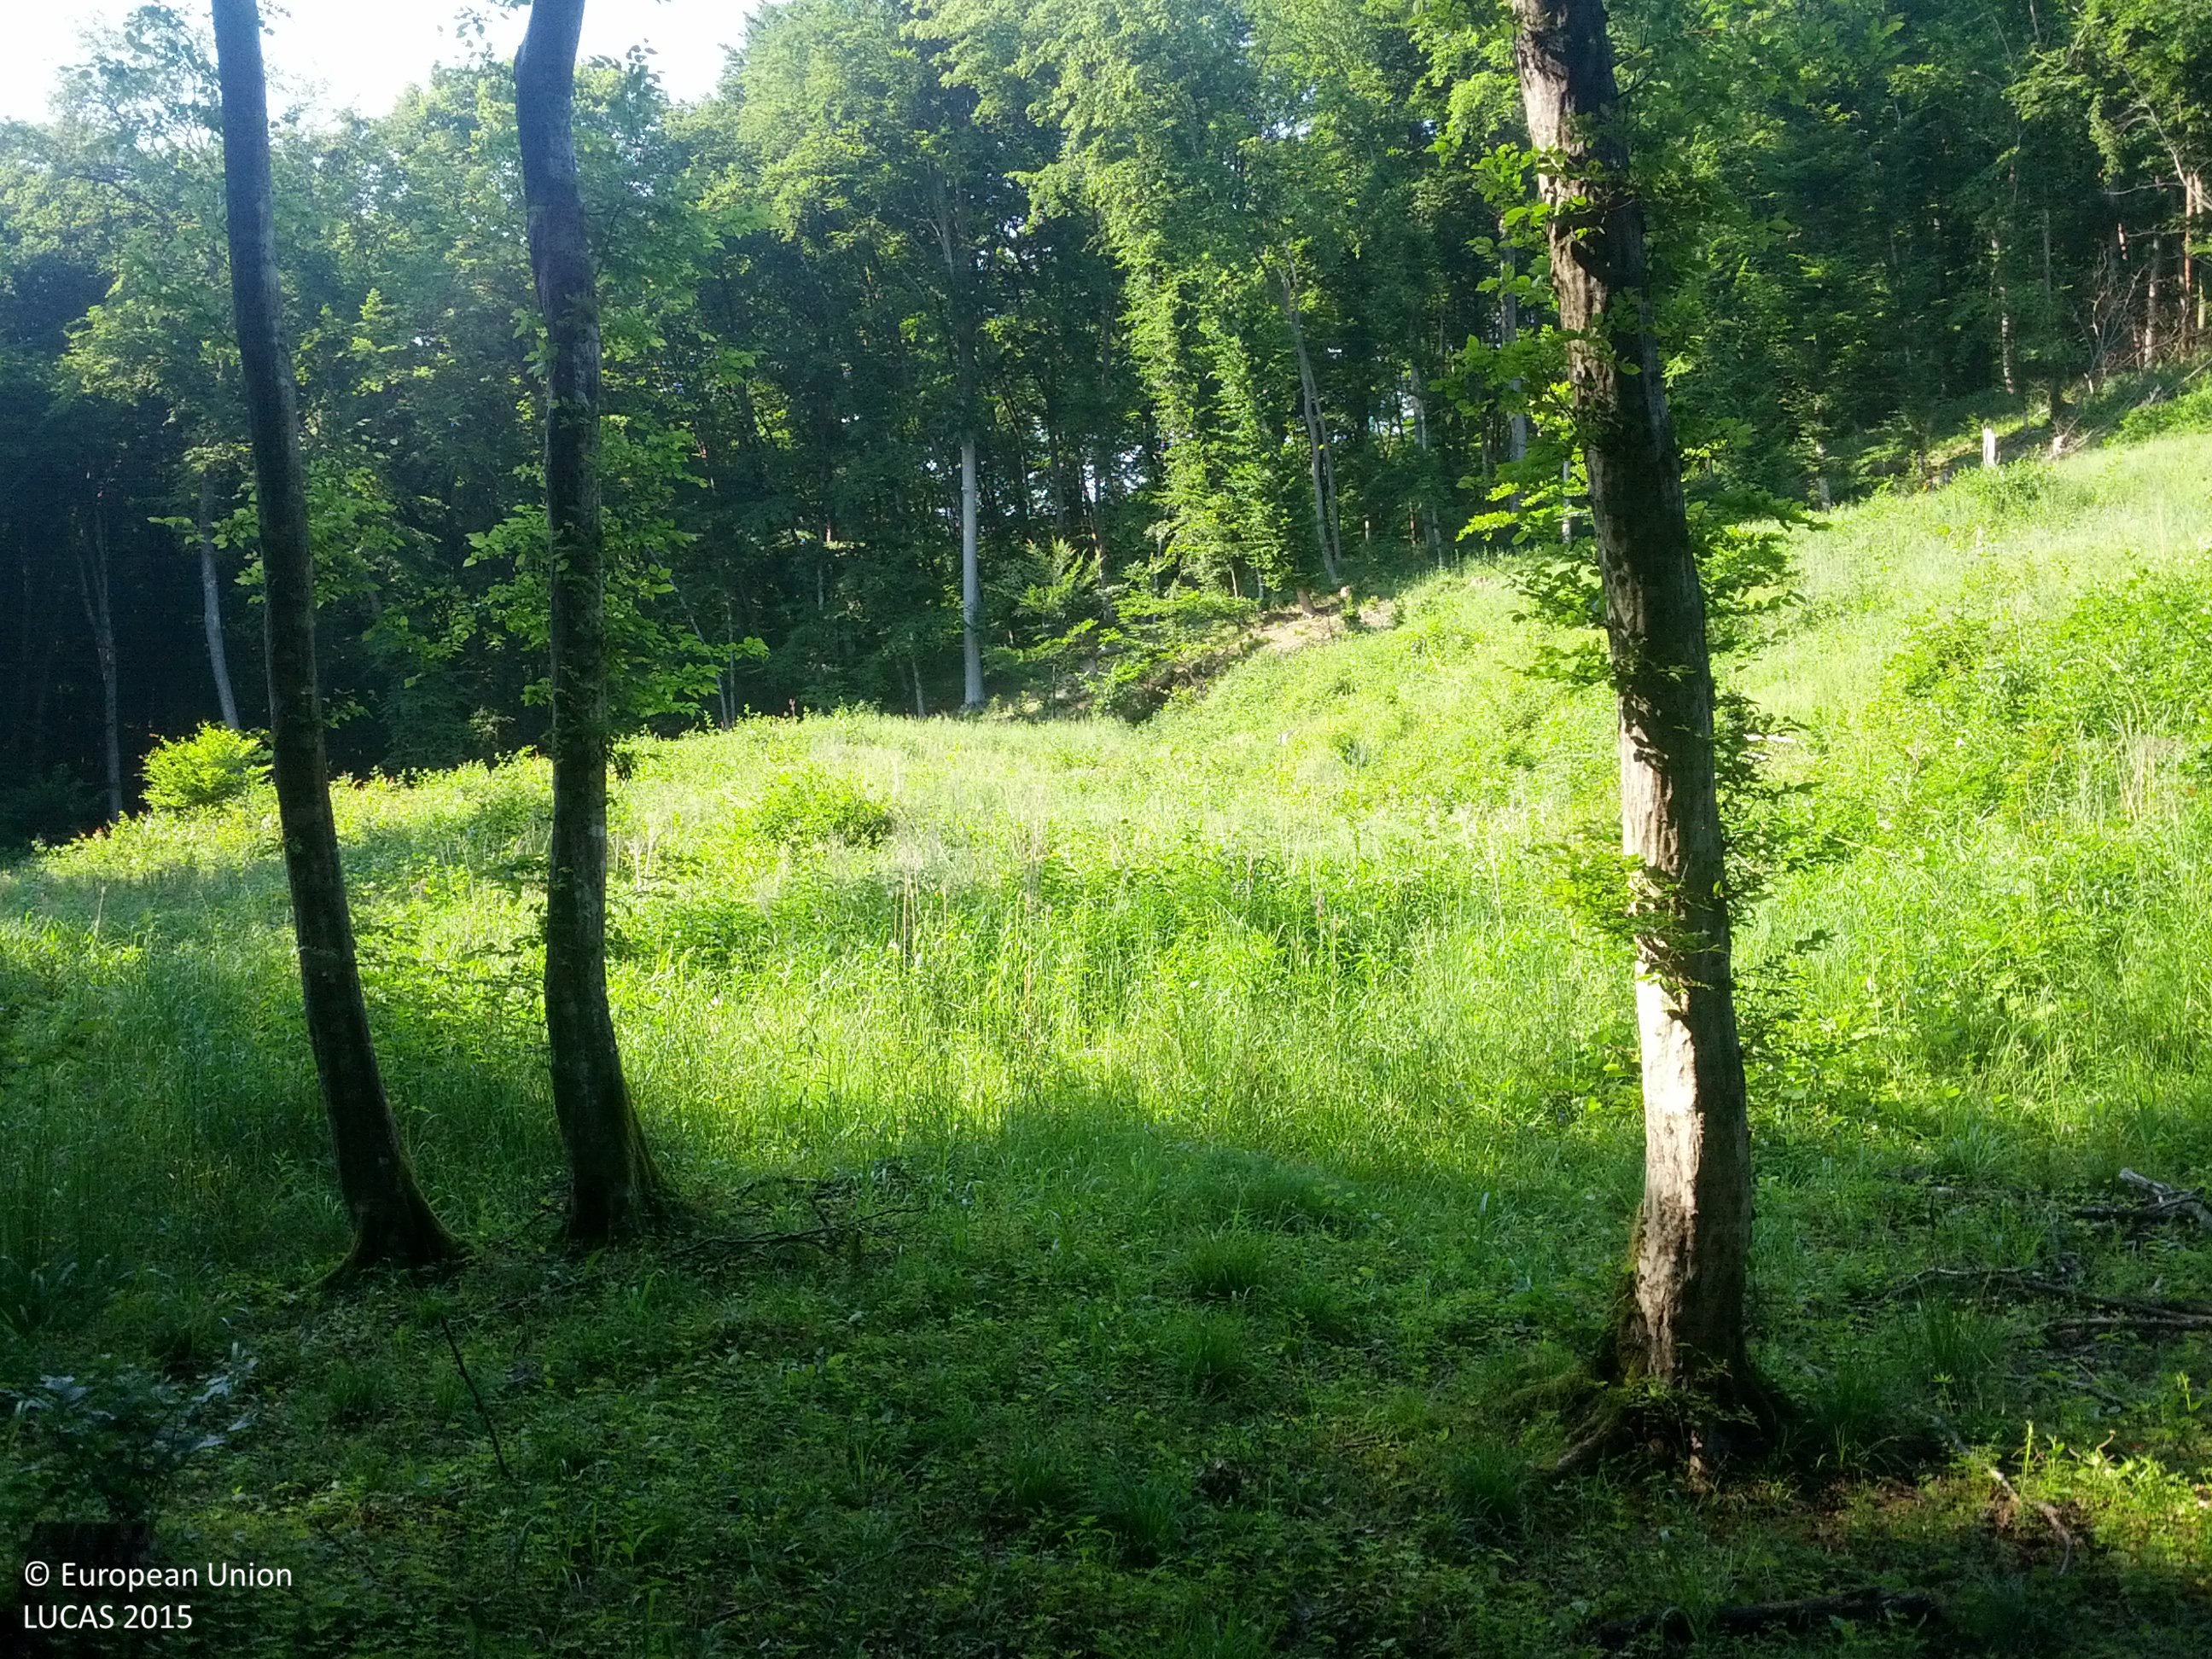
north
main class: Woodland
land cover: Broadleaved woodland
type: mountainous beech forest
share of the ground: > 75 %
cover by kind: broadleaved forest trees 80 %, herbaceous plants 15 %, coniferous forest trees 5 %
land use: Forestry
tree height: > 5 m
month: June
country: AT
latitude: 47.0275
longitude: 16.3838
